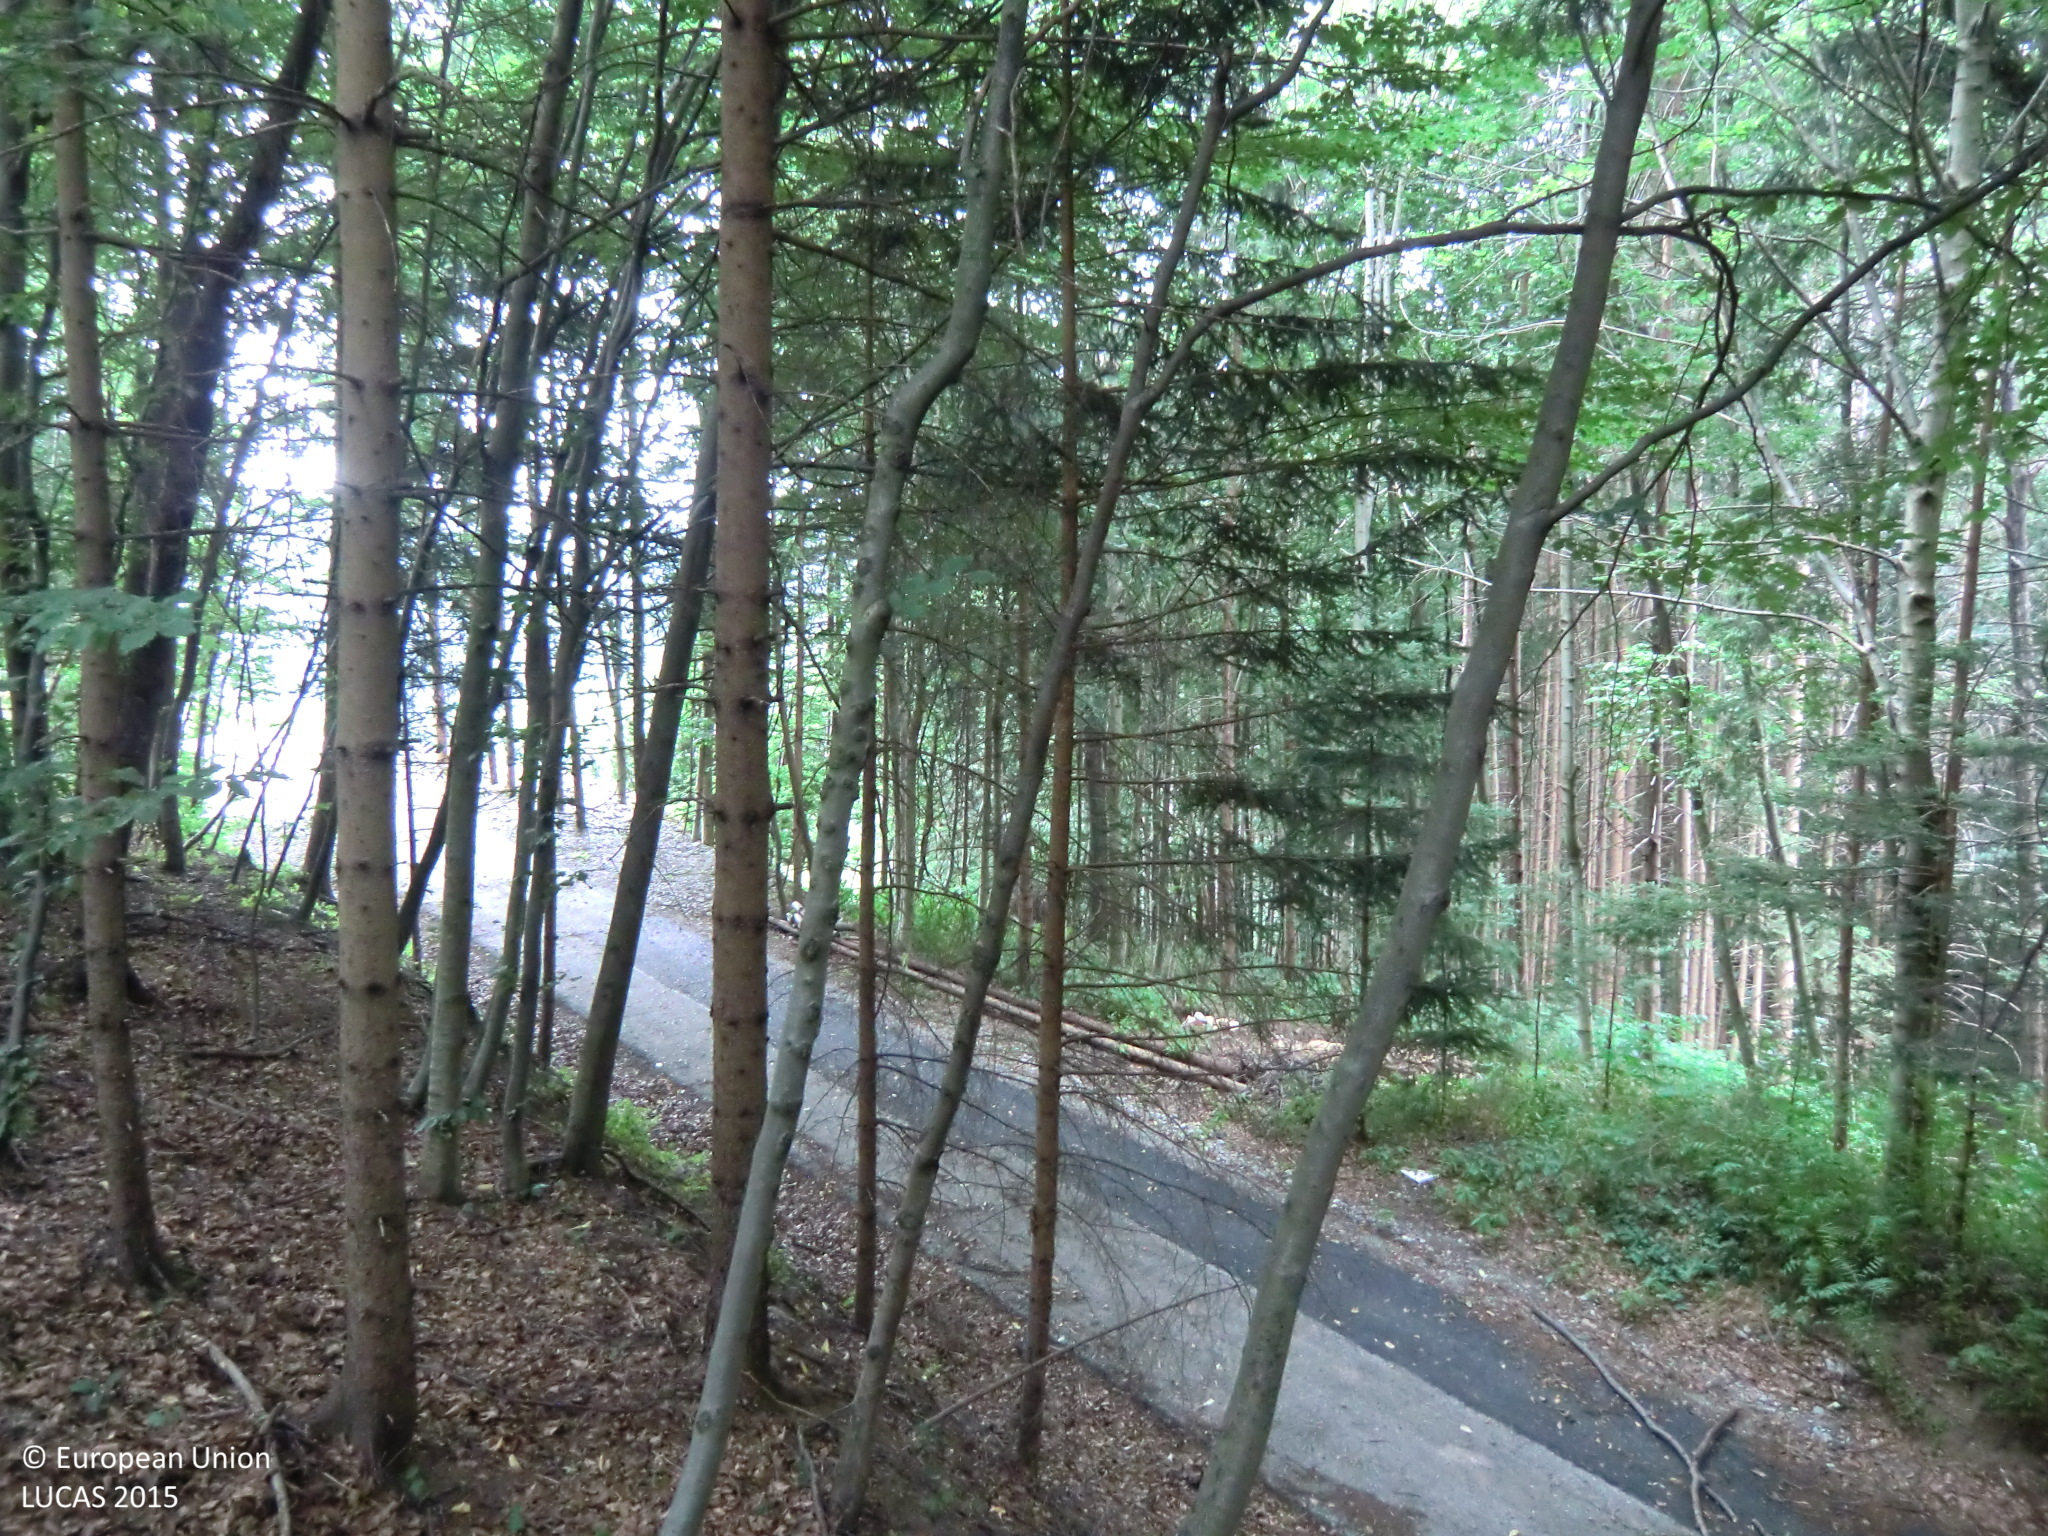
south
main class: Grassland
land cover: Grassland without tree/shrub cover
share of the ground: > 75 %
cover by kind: herbaceous plants 100 %
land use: Residential
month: July
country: AT
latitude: 47.1330
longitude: 15.4449
